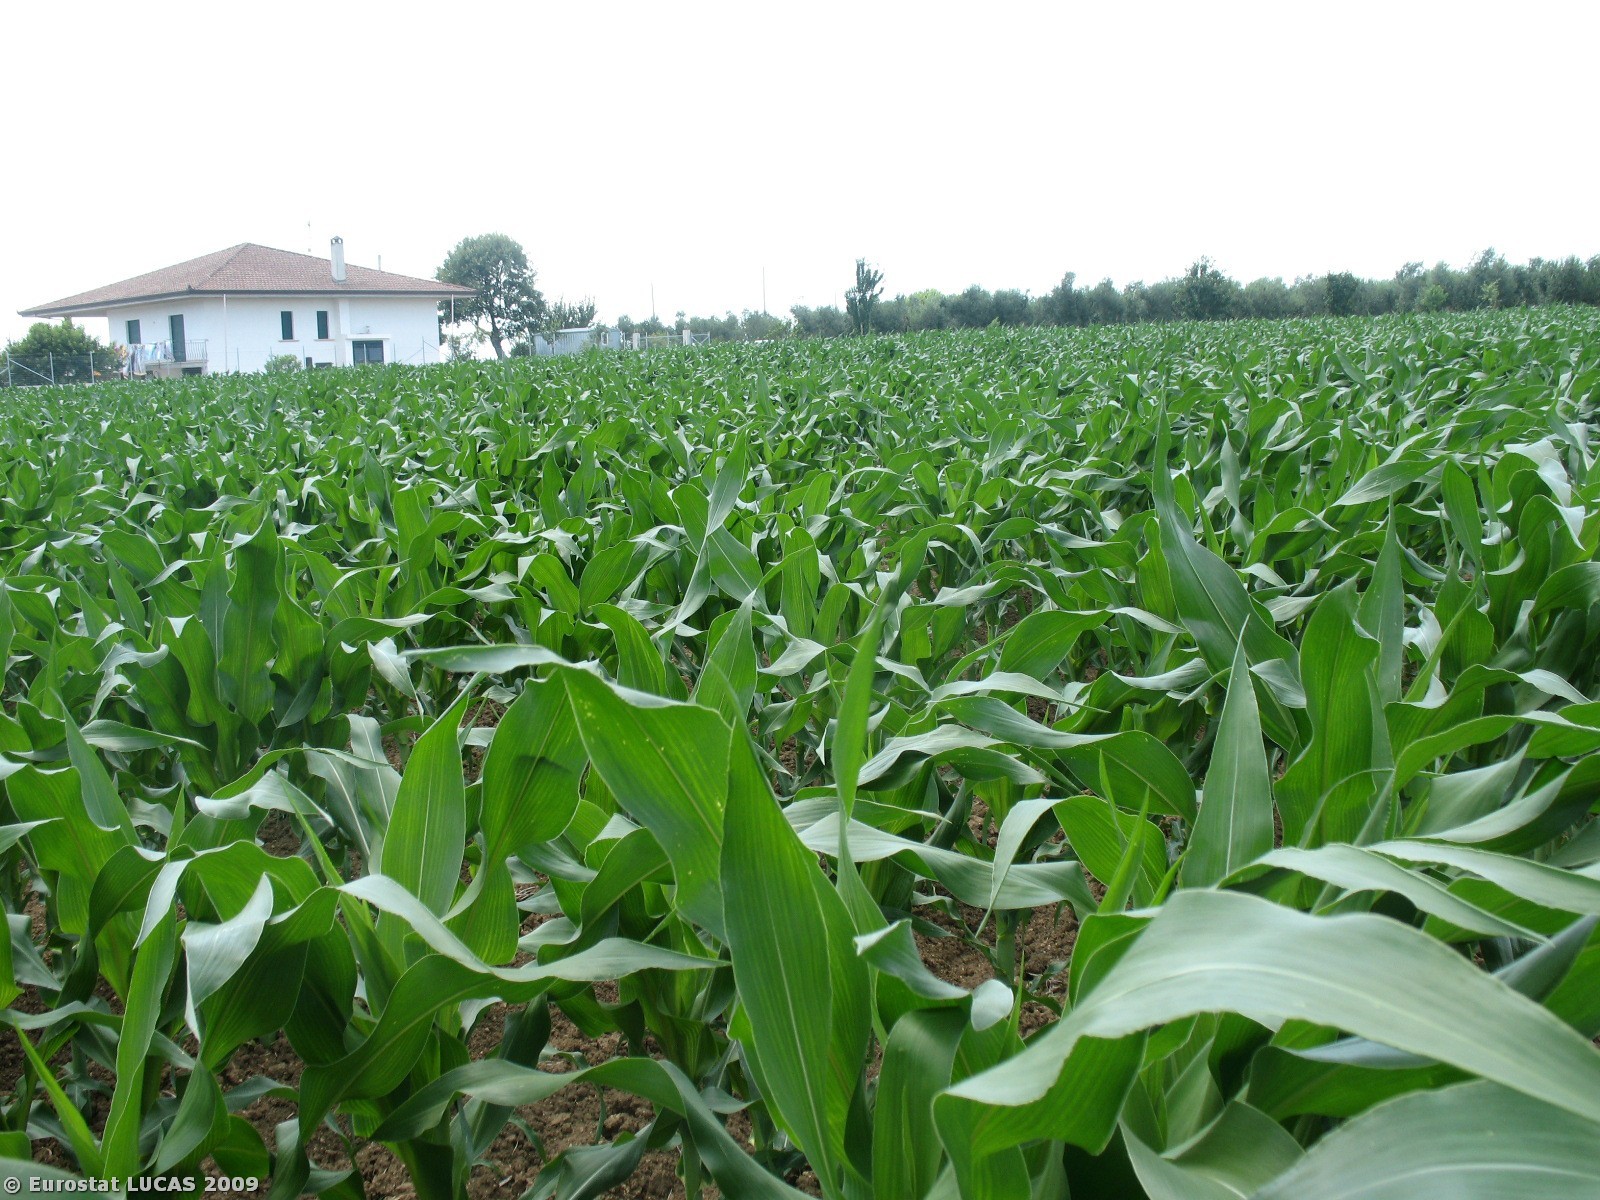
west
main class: Cropland
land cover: Maize
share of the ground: > 75 %
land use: Agriculture (excluding fallow land and kitchen gardens)
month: July
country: IT
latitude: 40.5340
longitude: 15.0905
